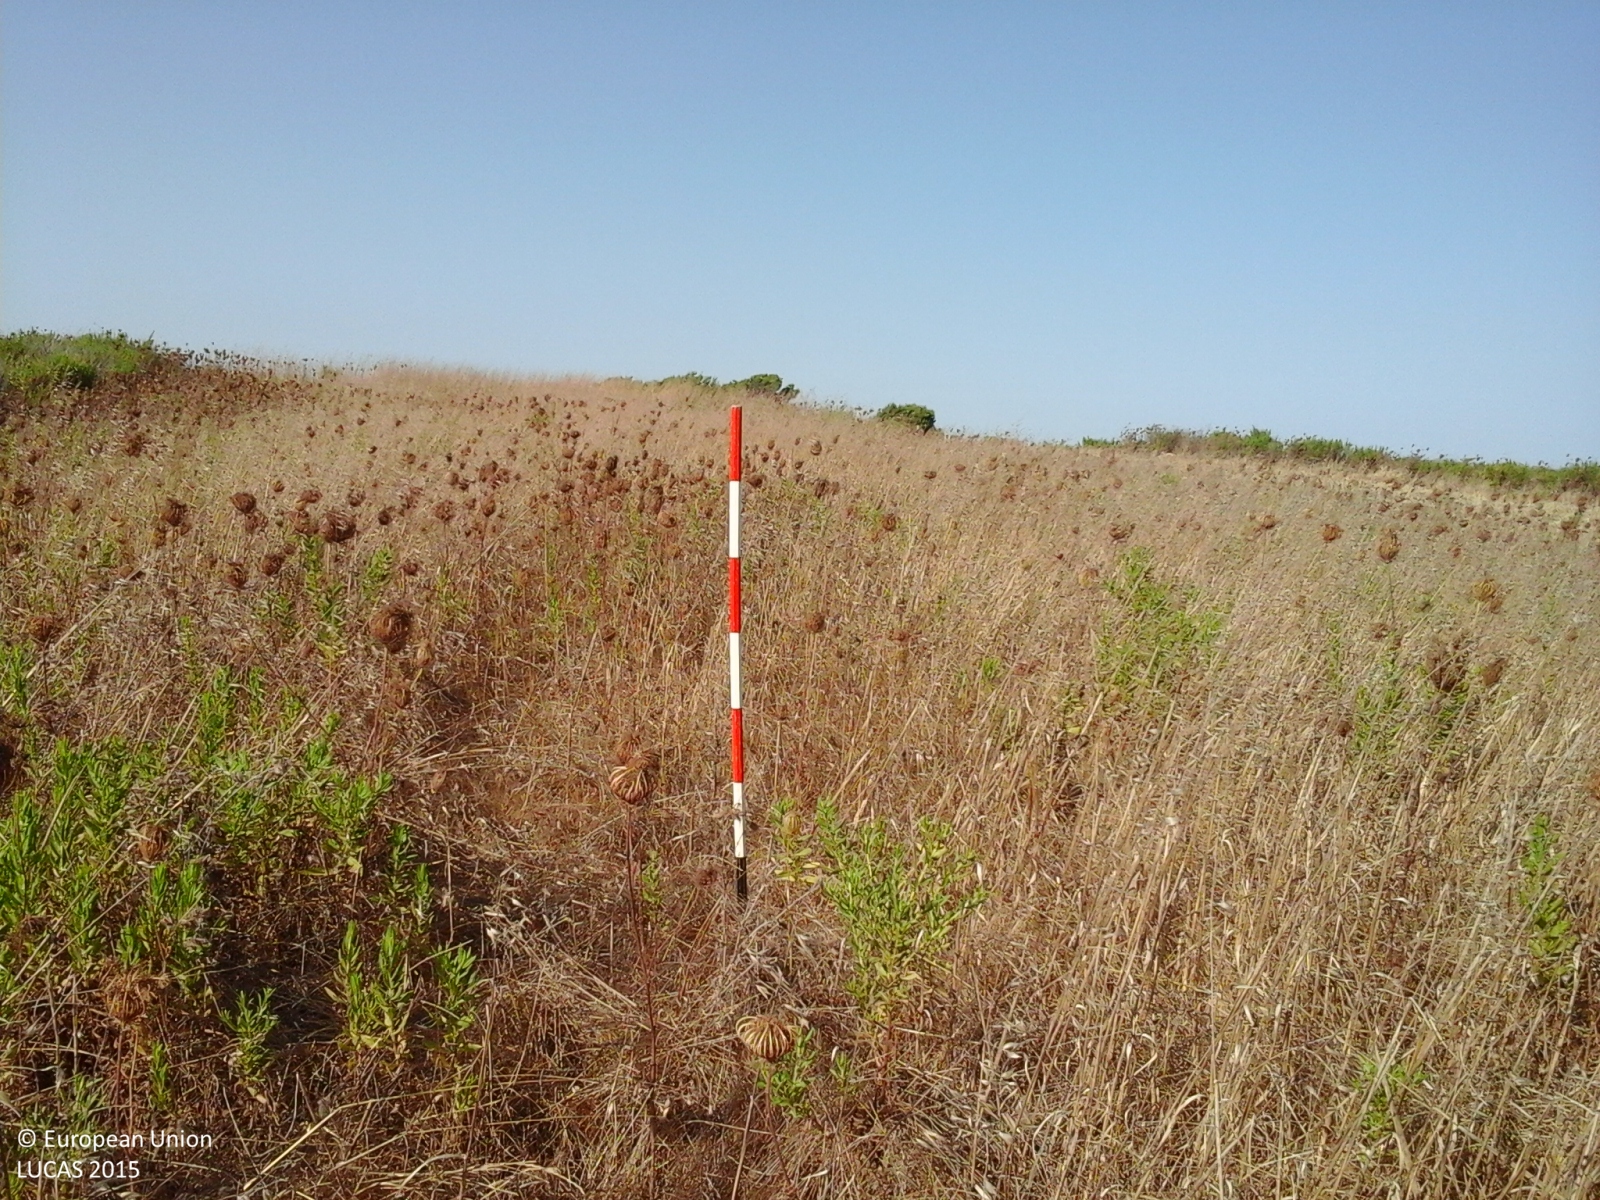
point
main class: Grassland
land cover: Spontaneously vegetated surfaces
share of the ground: > 75 %
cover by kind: herbaceous plants 100 %
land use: Fallow land
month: July
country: IT
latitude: 39.8926
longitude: 8.4299
